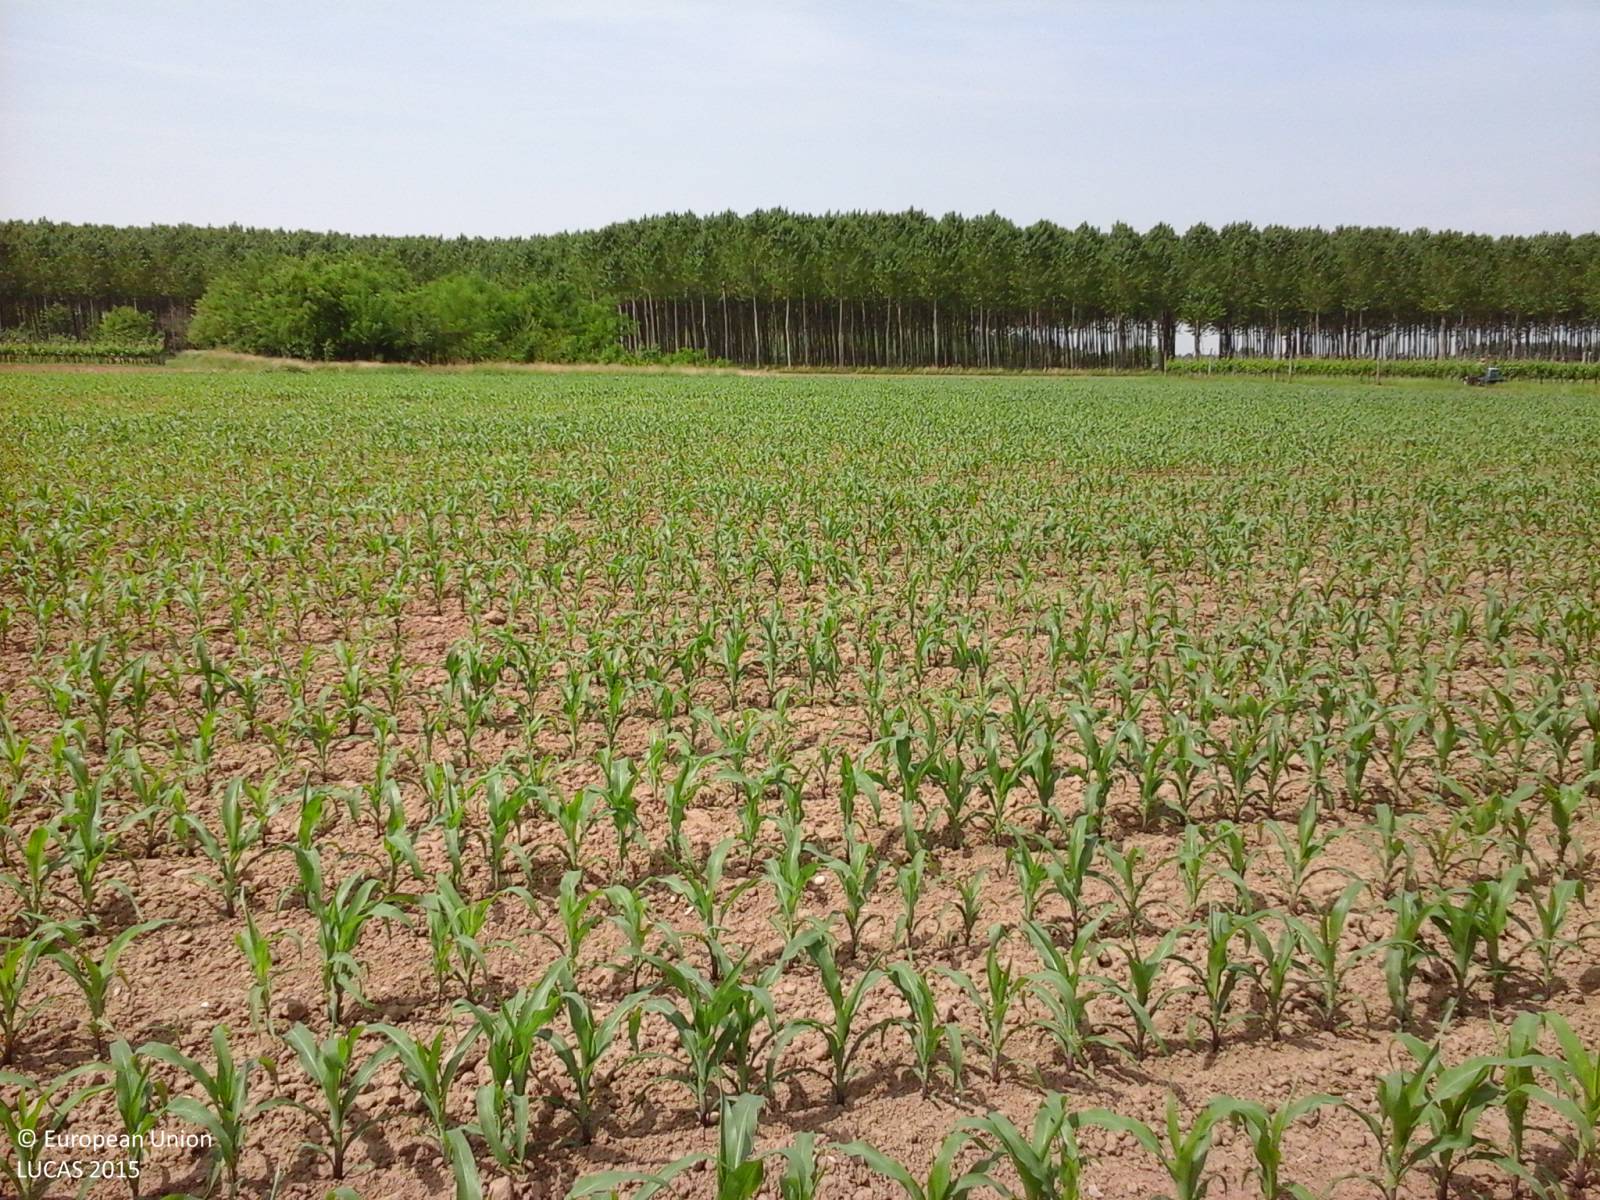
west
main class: Cropland
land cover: Maize
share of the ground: 25 - 50 %
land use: Agriculture (excluding fallow land and kitchen gardens)
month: May
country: IT
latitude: 45.9754
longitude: 13.3133
